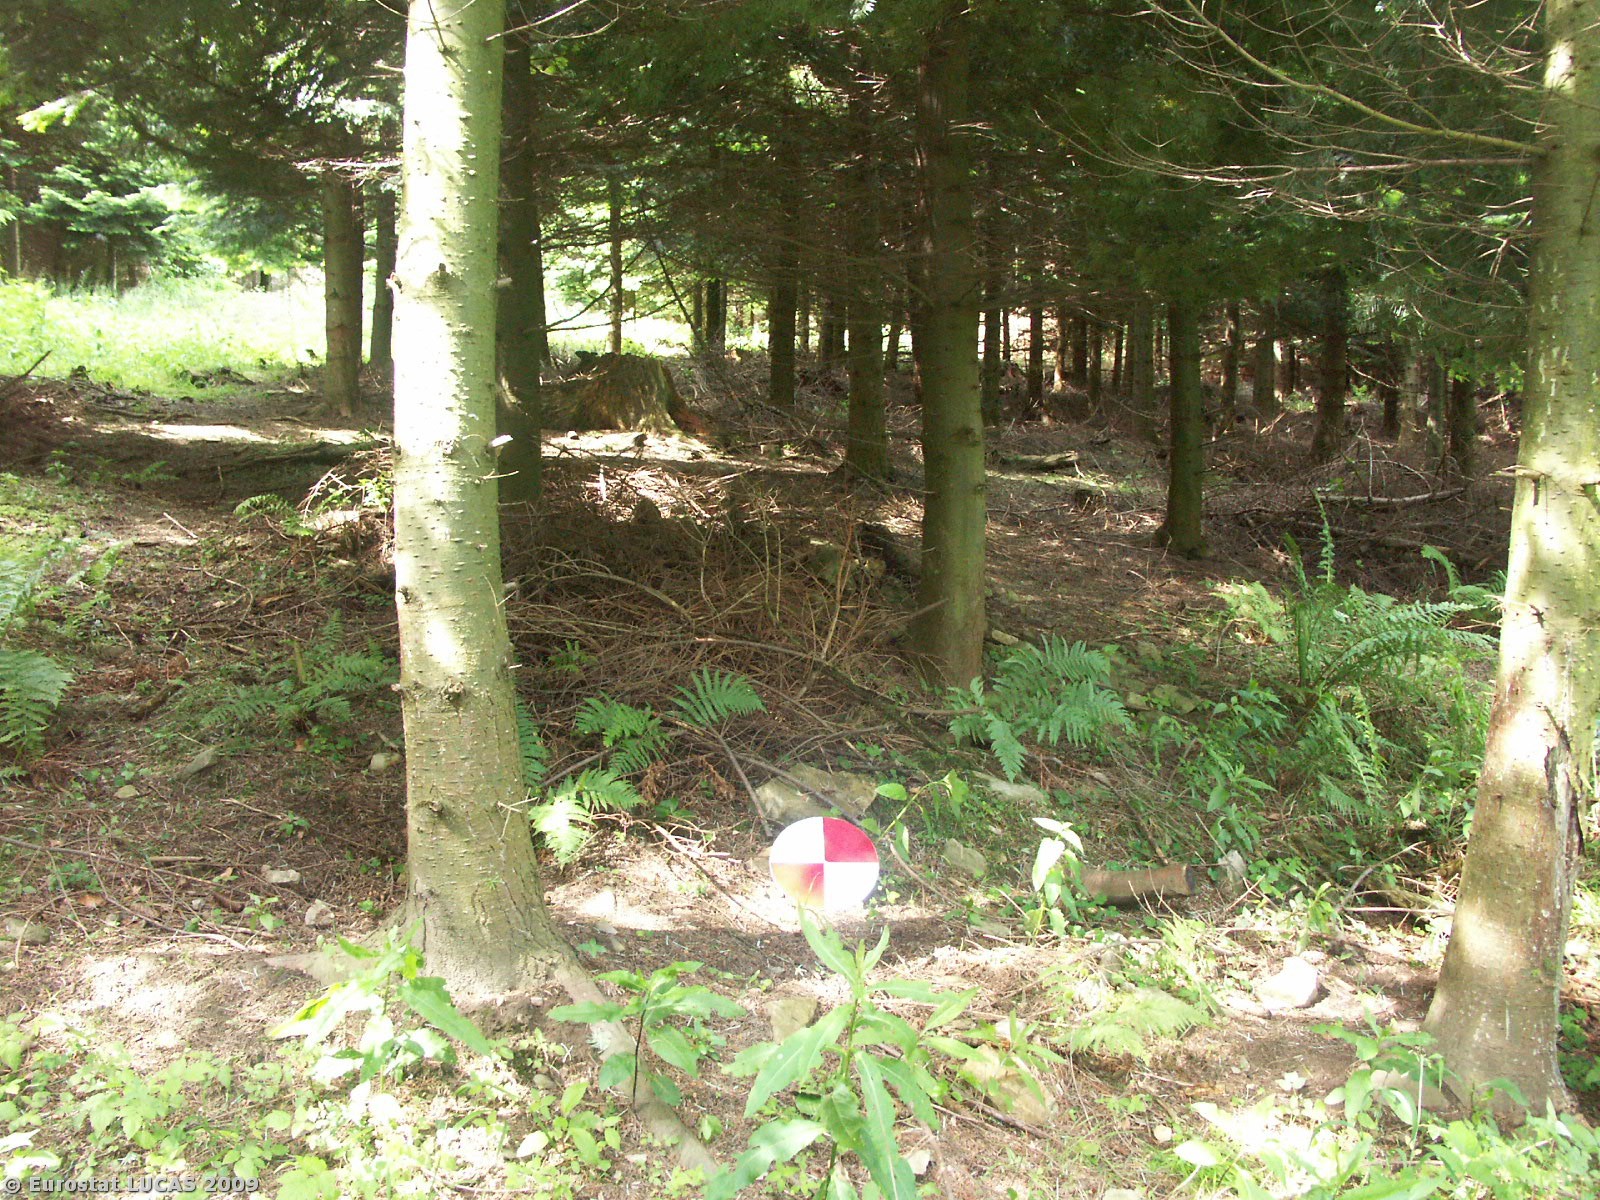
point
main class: Woodland
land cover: Coniferous woodland
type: hemiboreal forest and nemoral coniferous forest and mixed broadleaved-coniferous forest
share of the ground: > 75 %
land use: Forestry
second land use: Nature reserves
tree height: > 5 m
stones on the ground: 25 - 50 %
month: May
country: CZ
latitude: 48.9545
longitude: 14.1932
